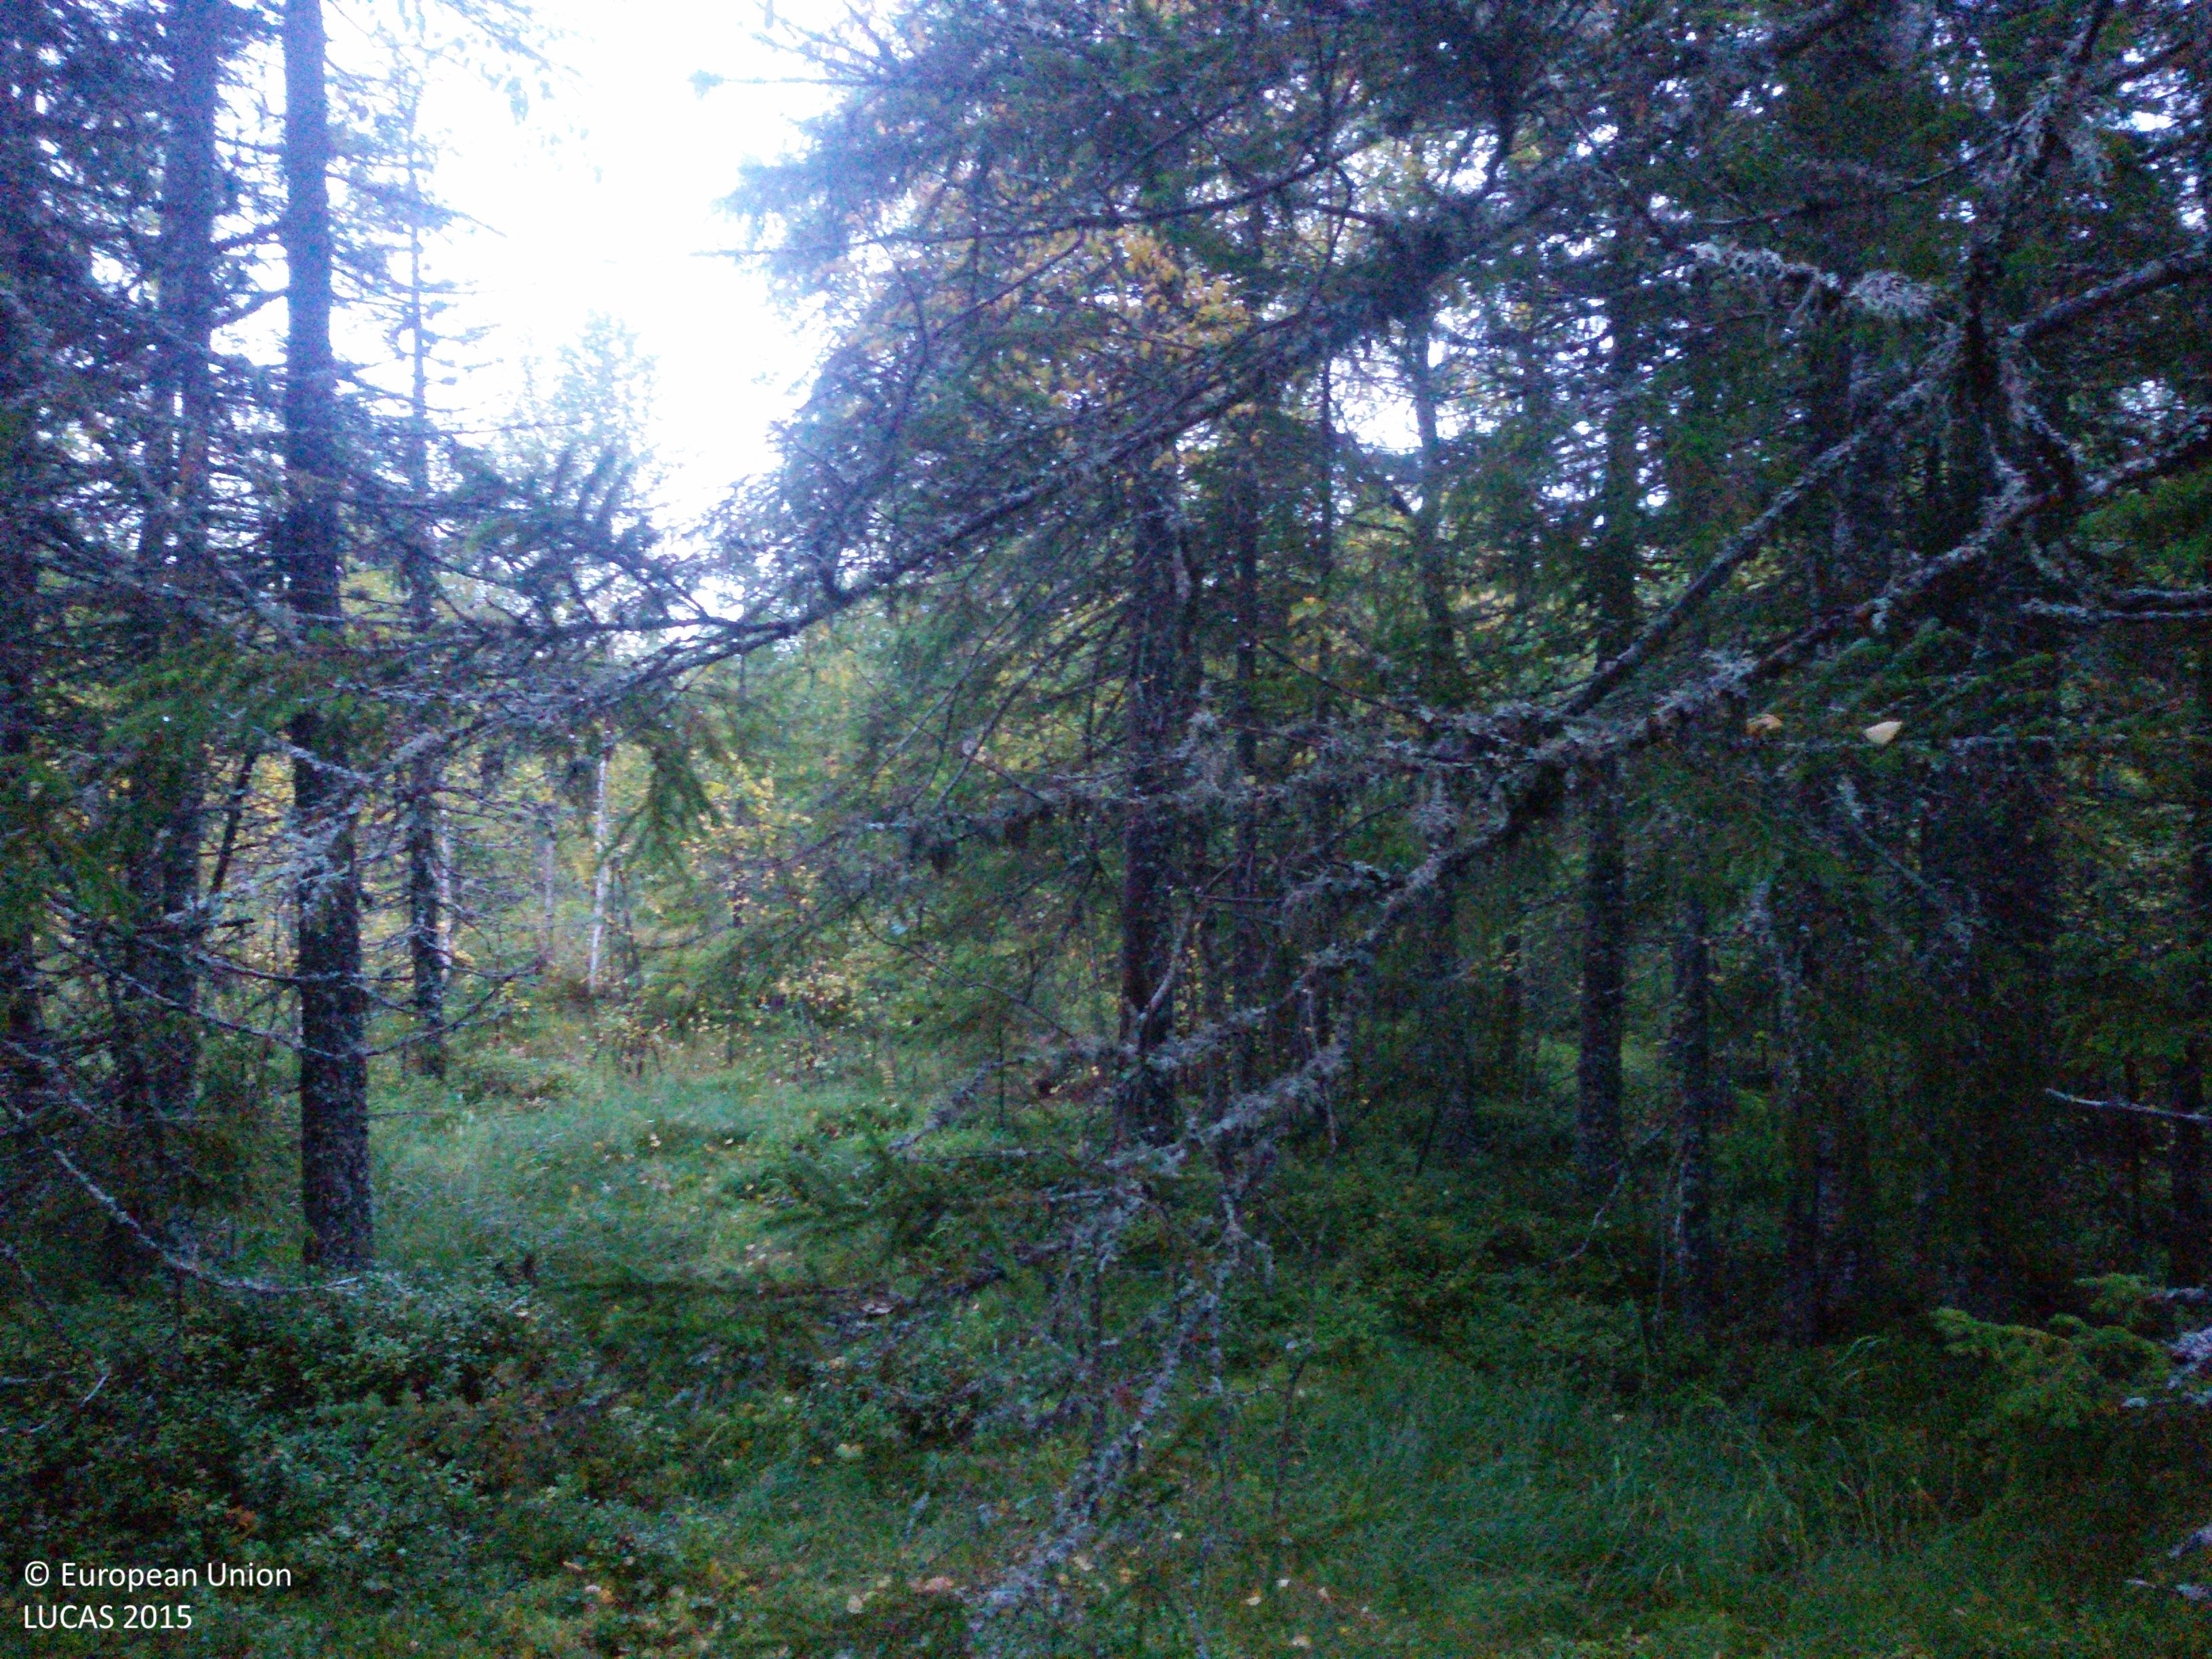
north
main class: Woodland
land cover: Spruce dominated mixed woodland
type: boreal forest
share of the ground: > 75 %
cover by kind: coniferous forest trees 40 %, broadleaved forest trees 30 %, herbaceous plants 20 %, lichens and mosses 10 %
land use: Forestry
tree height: > 5 m
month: September
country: SE
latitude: 60.9810
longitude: 14.2928
